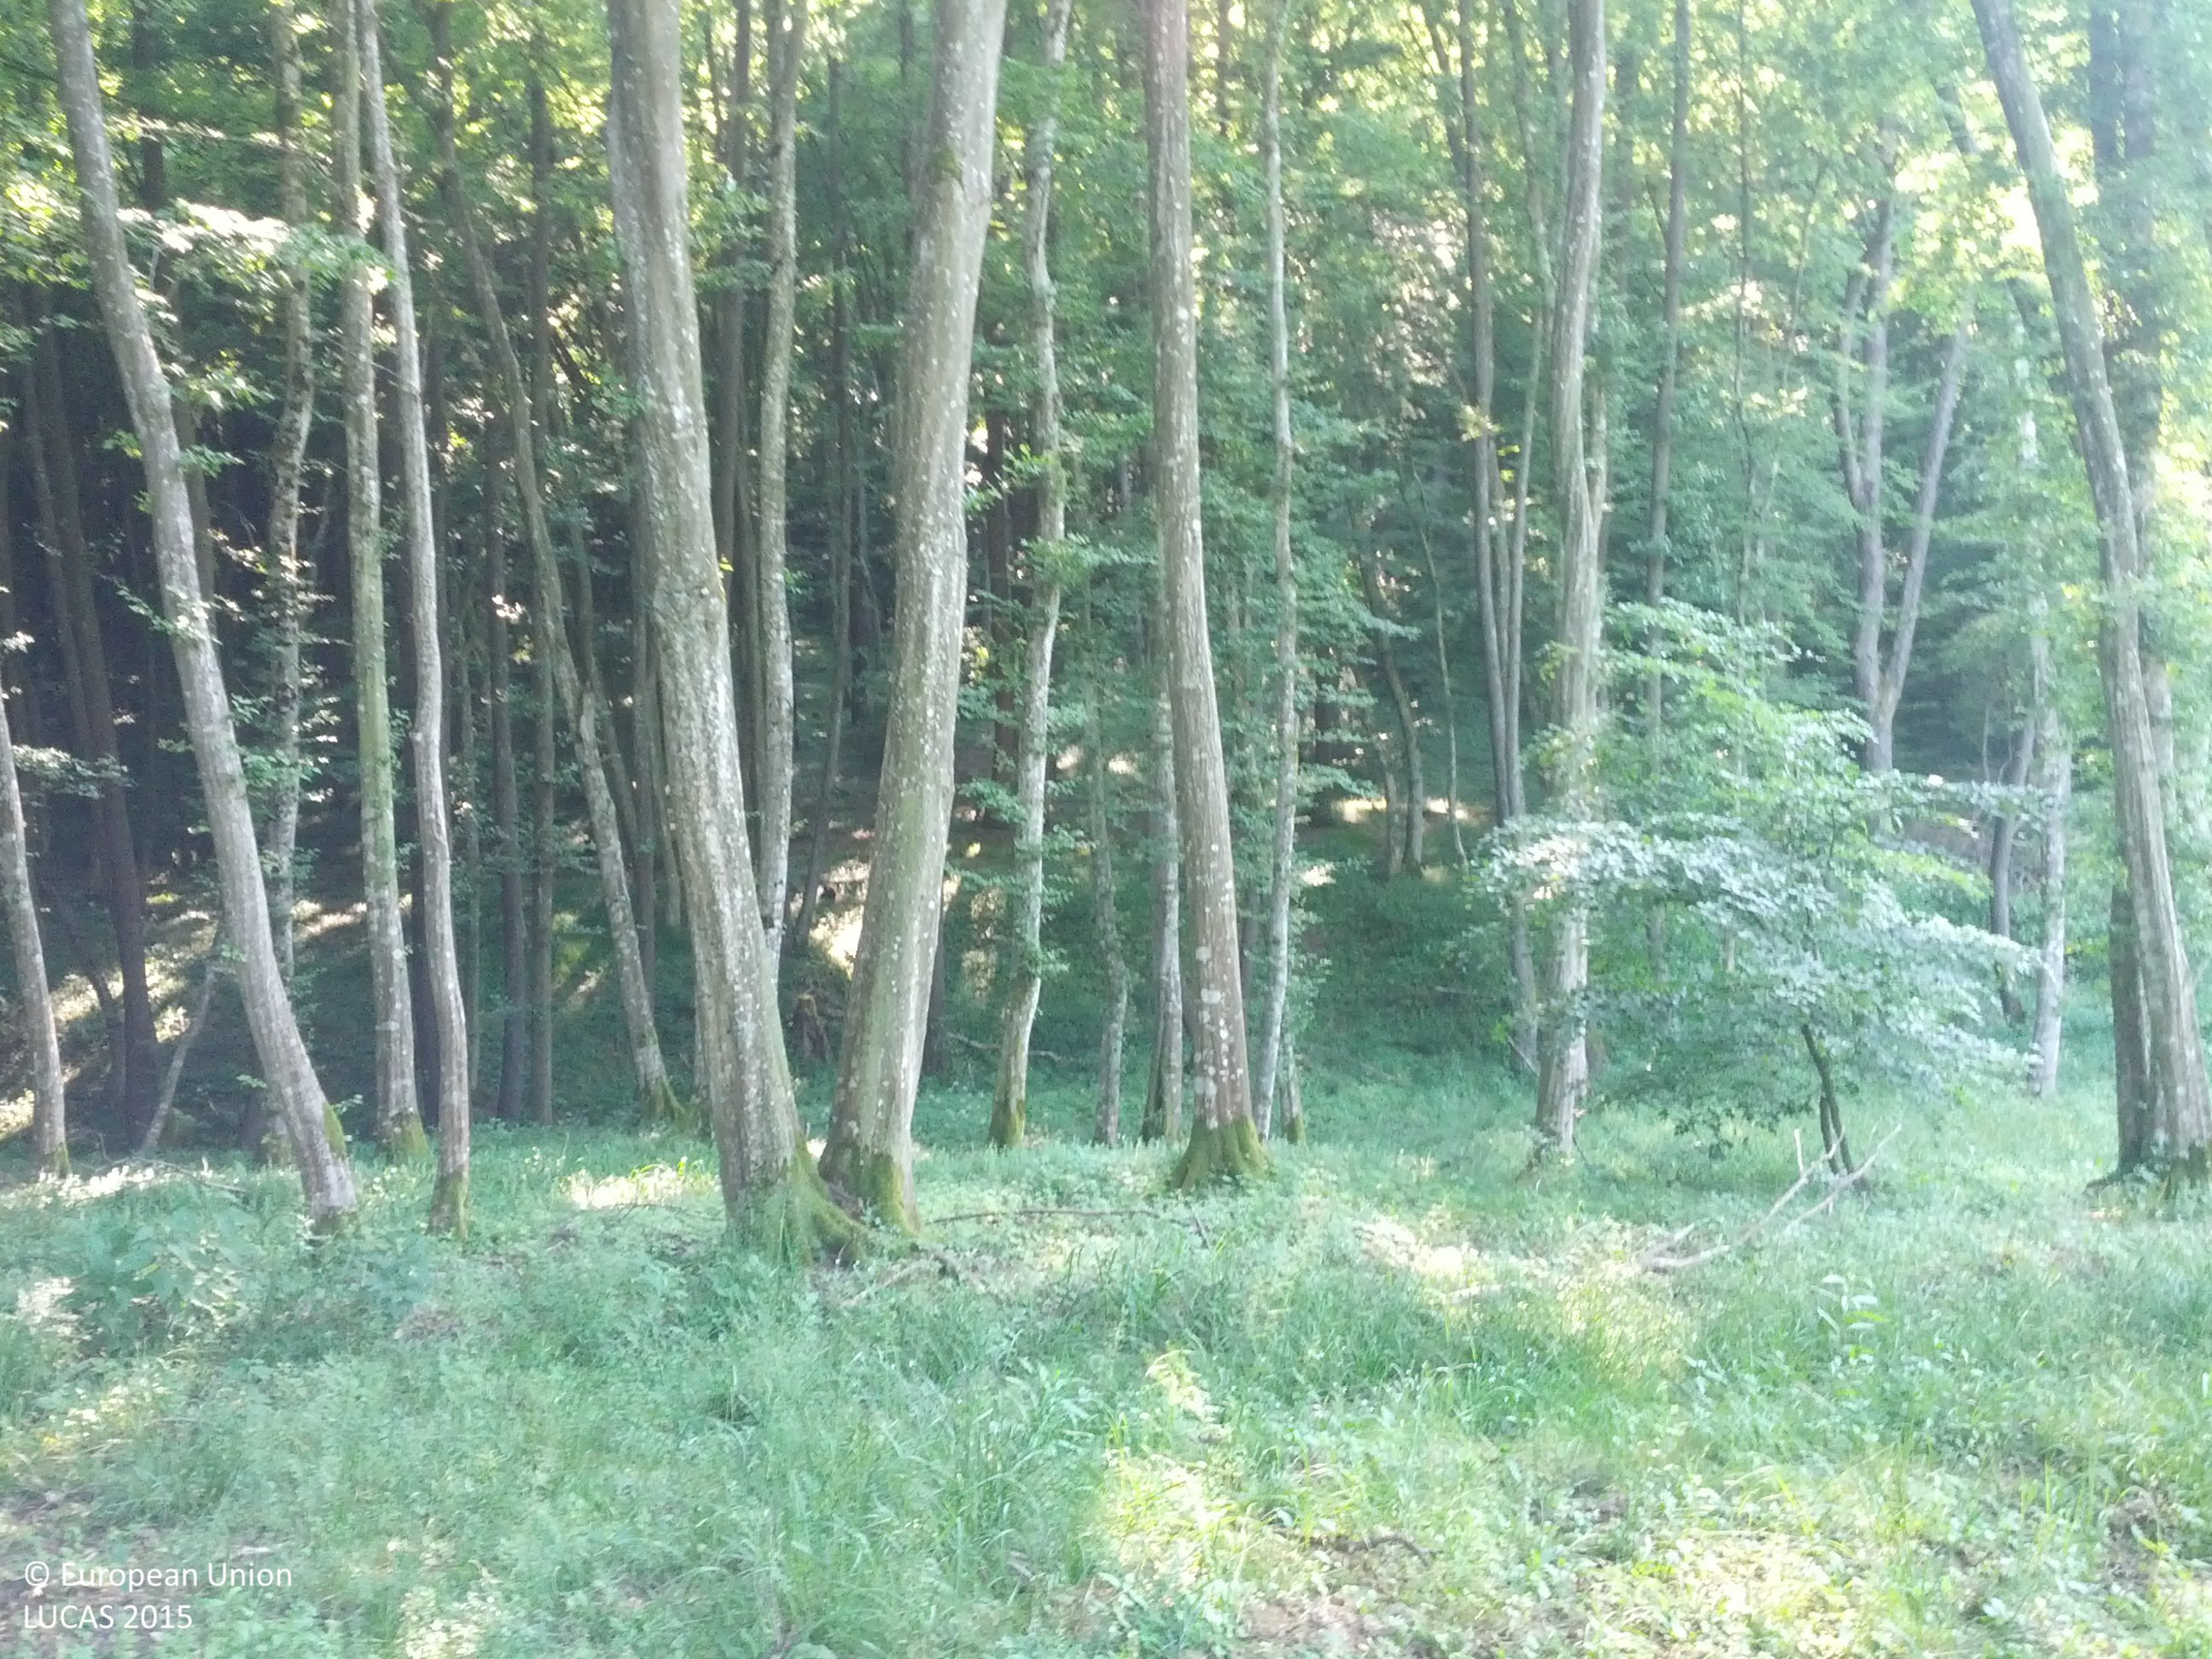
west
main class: Woodland
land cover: Broadleaved woodland
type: mountainous beech forest
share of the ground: > 75 %
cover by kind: broadleaved forest trees 80 %, herbaceous plants 15 %, coniferous forest trees 5 %
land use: Forestry
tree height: > 5 m
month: June
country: AT
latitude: 47.0275
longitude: 16.3838
